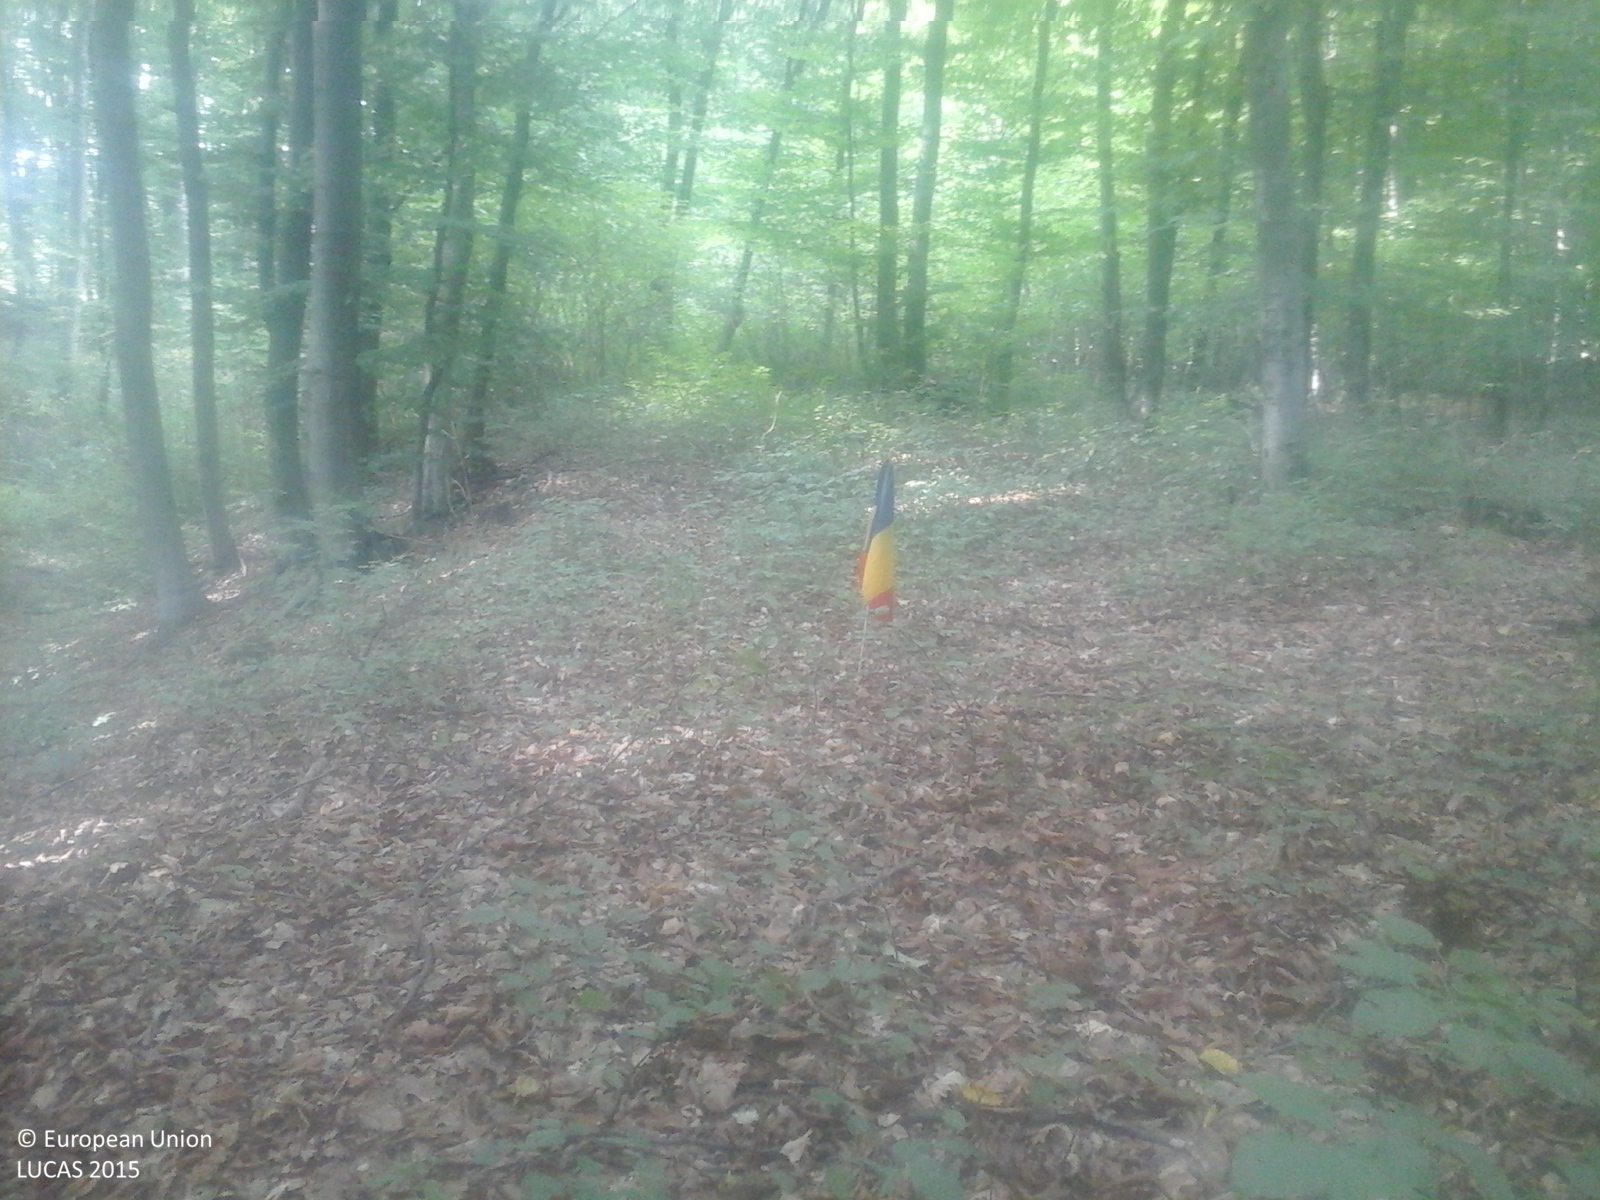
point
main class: Woodland
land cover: Broadleaved woodland
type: beech forest
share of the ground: > 75 %
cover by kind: broadleaved forest trees 100 %
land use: Forestry
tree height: > 5 m
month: September
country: RO
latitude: 47.1452
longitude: 23.1066
